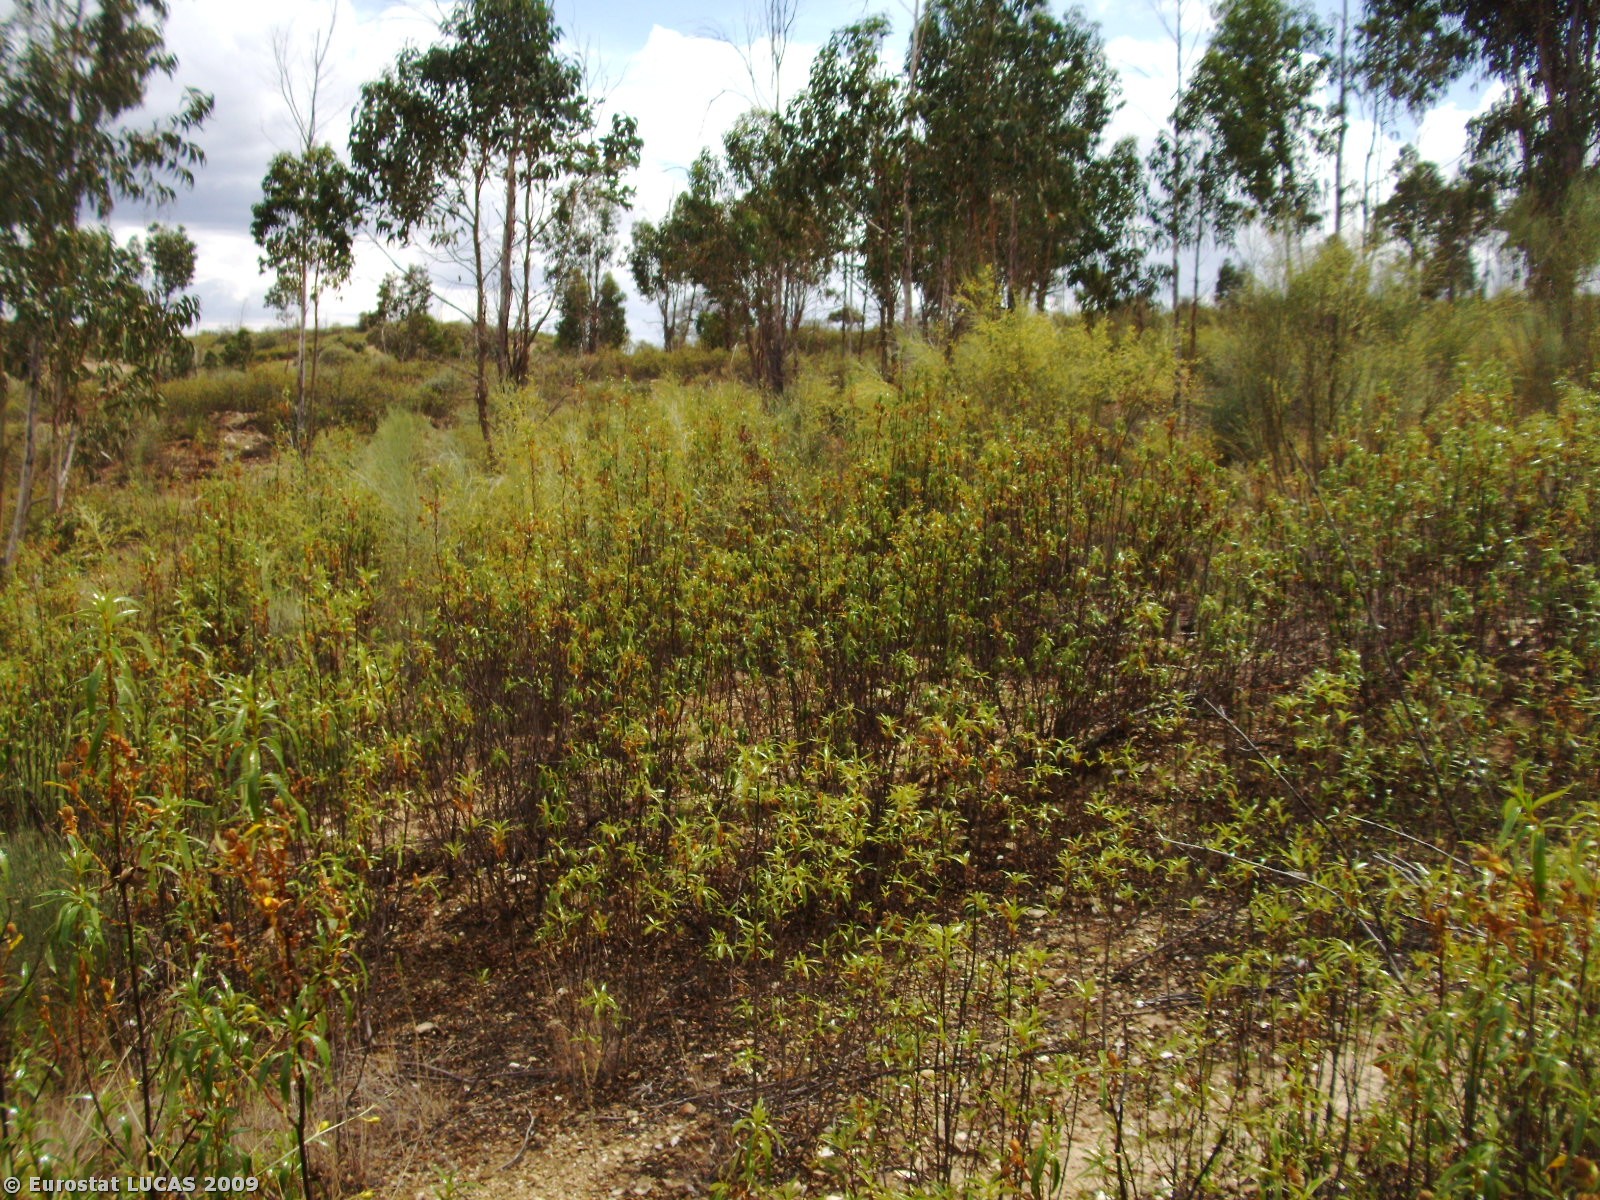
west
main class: Woodland
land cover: Broadleaved woodland
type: plantations and self-sown exotic forest
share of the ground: 25 - 50 %
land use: Forestry
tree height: > 5 m
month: June
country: PT
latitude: 39.9806
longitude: -6.9394
